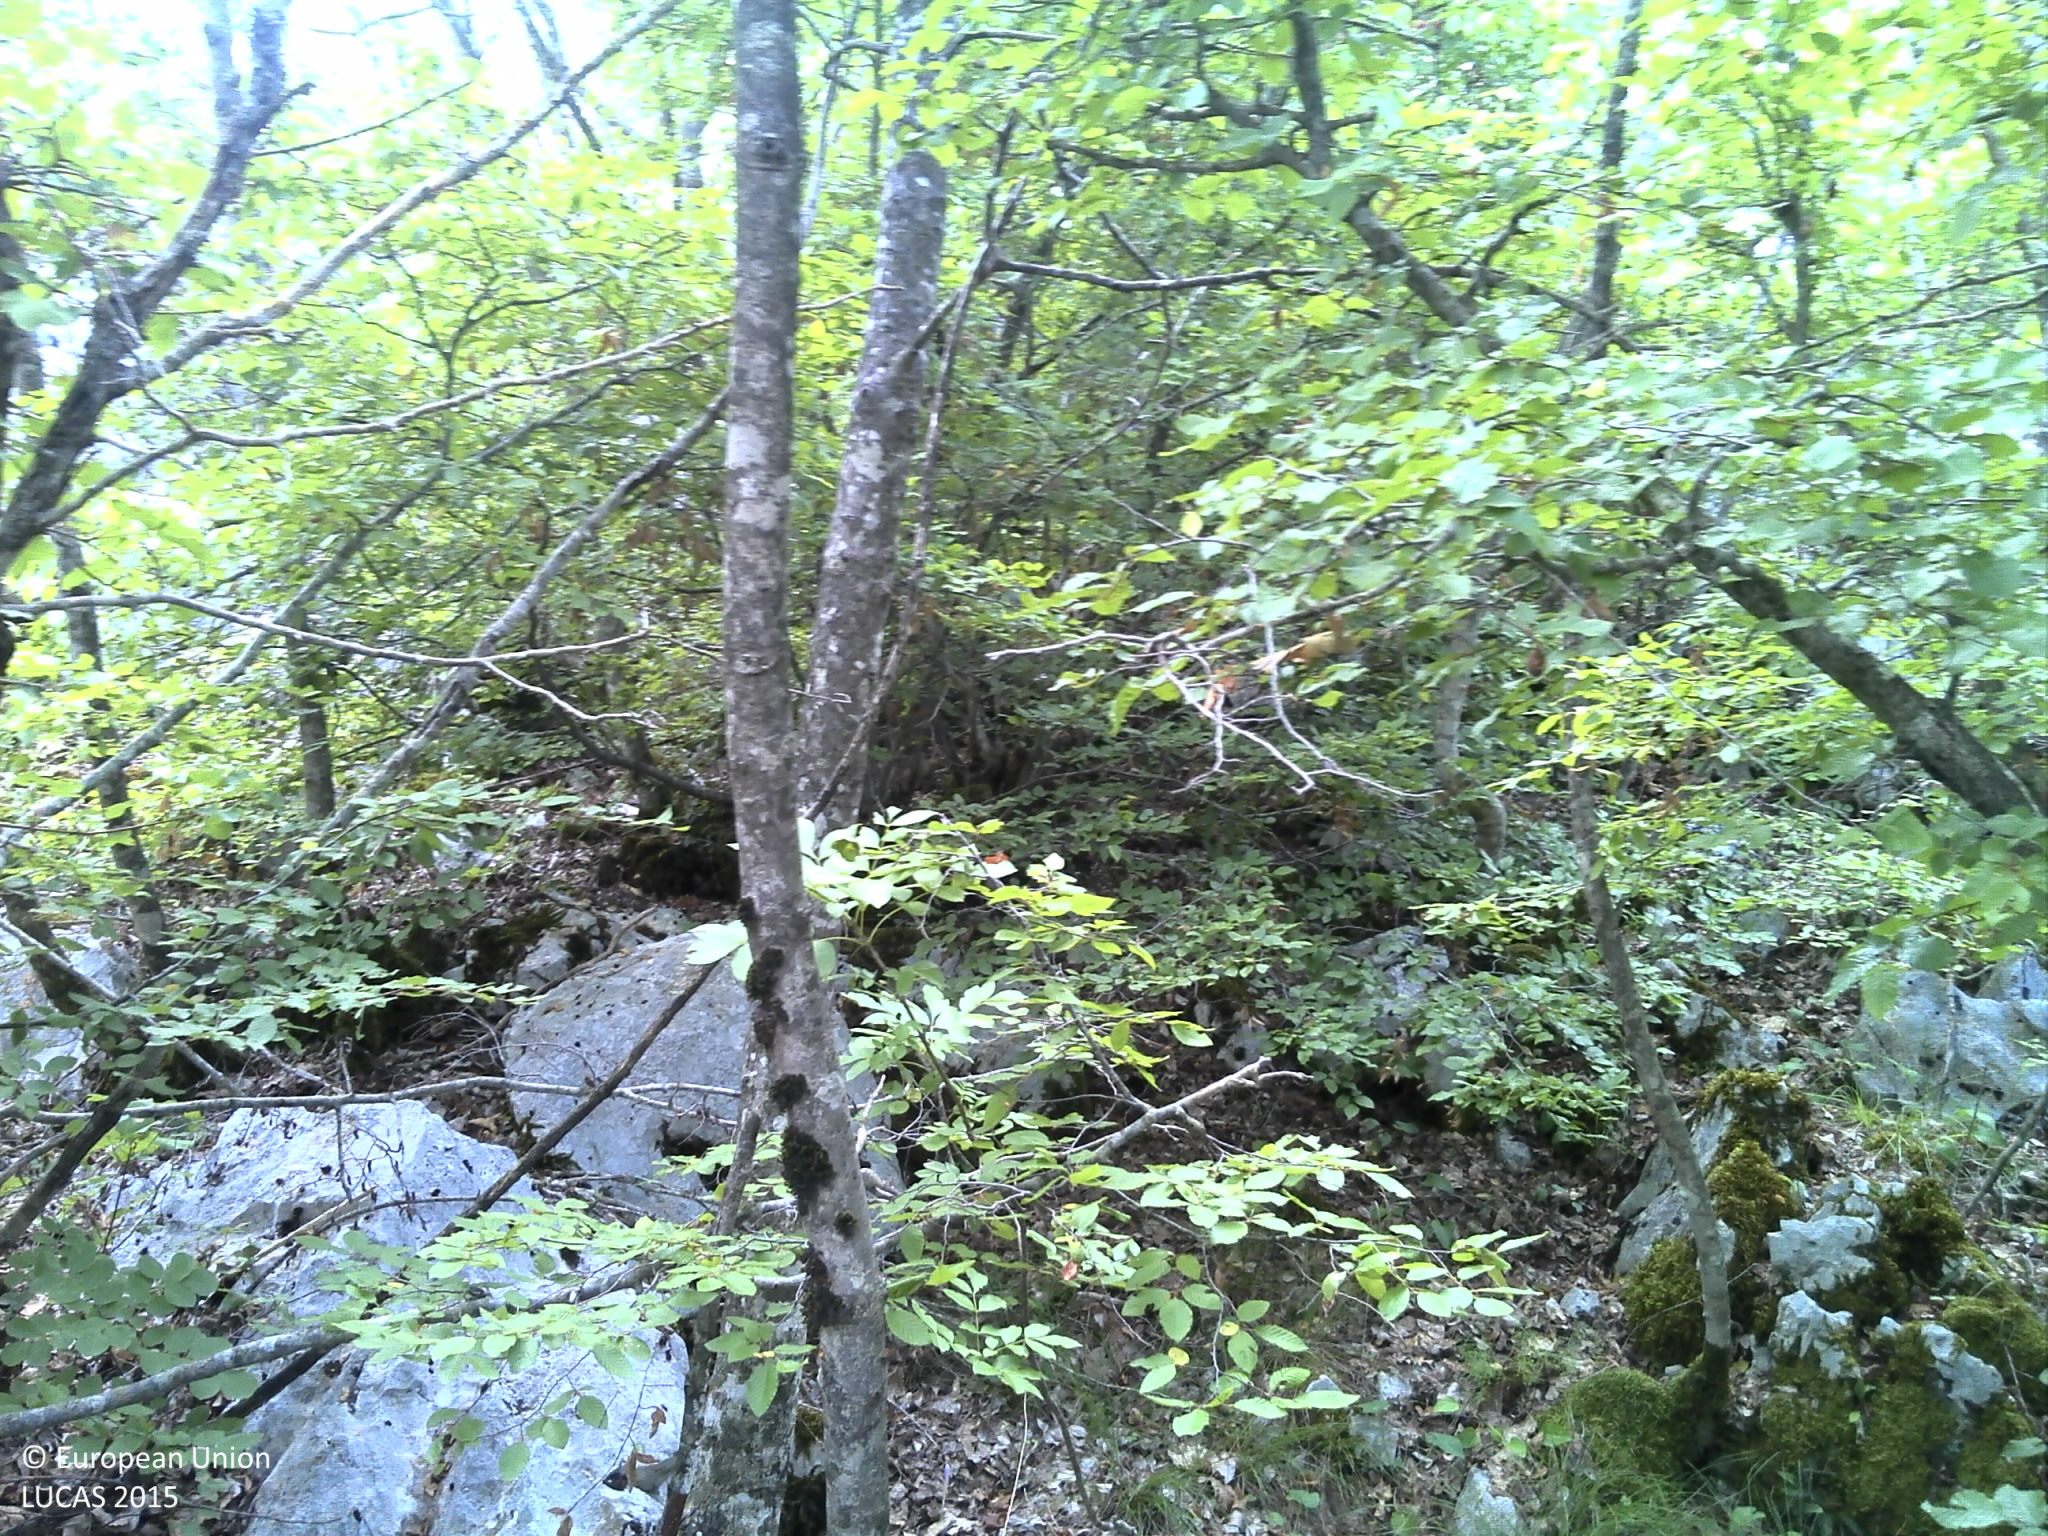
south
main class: Woodland
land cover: Broadleaved woodland
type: thermophilous deciduous forest
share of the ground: > 75 %
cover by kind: broadleaved forest trees 45 %, shrubs 30 %, herbaceous plants 10 %, consolidated bare surface 10 %, unconsolidated bare surface 5 %
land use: Semi-natural and natural areas not in use
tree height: > 5 m
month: August
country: HR
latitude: 43.3178
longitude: 17.2541
